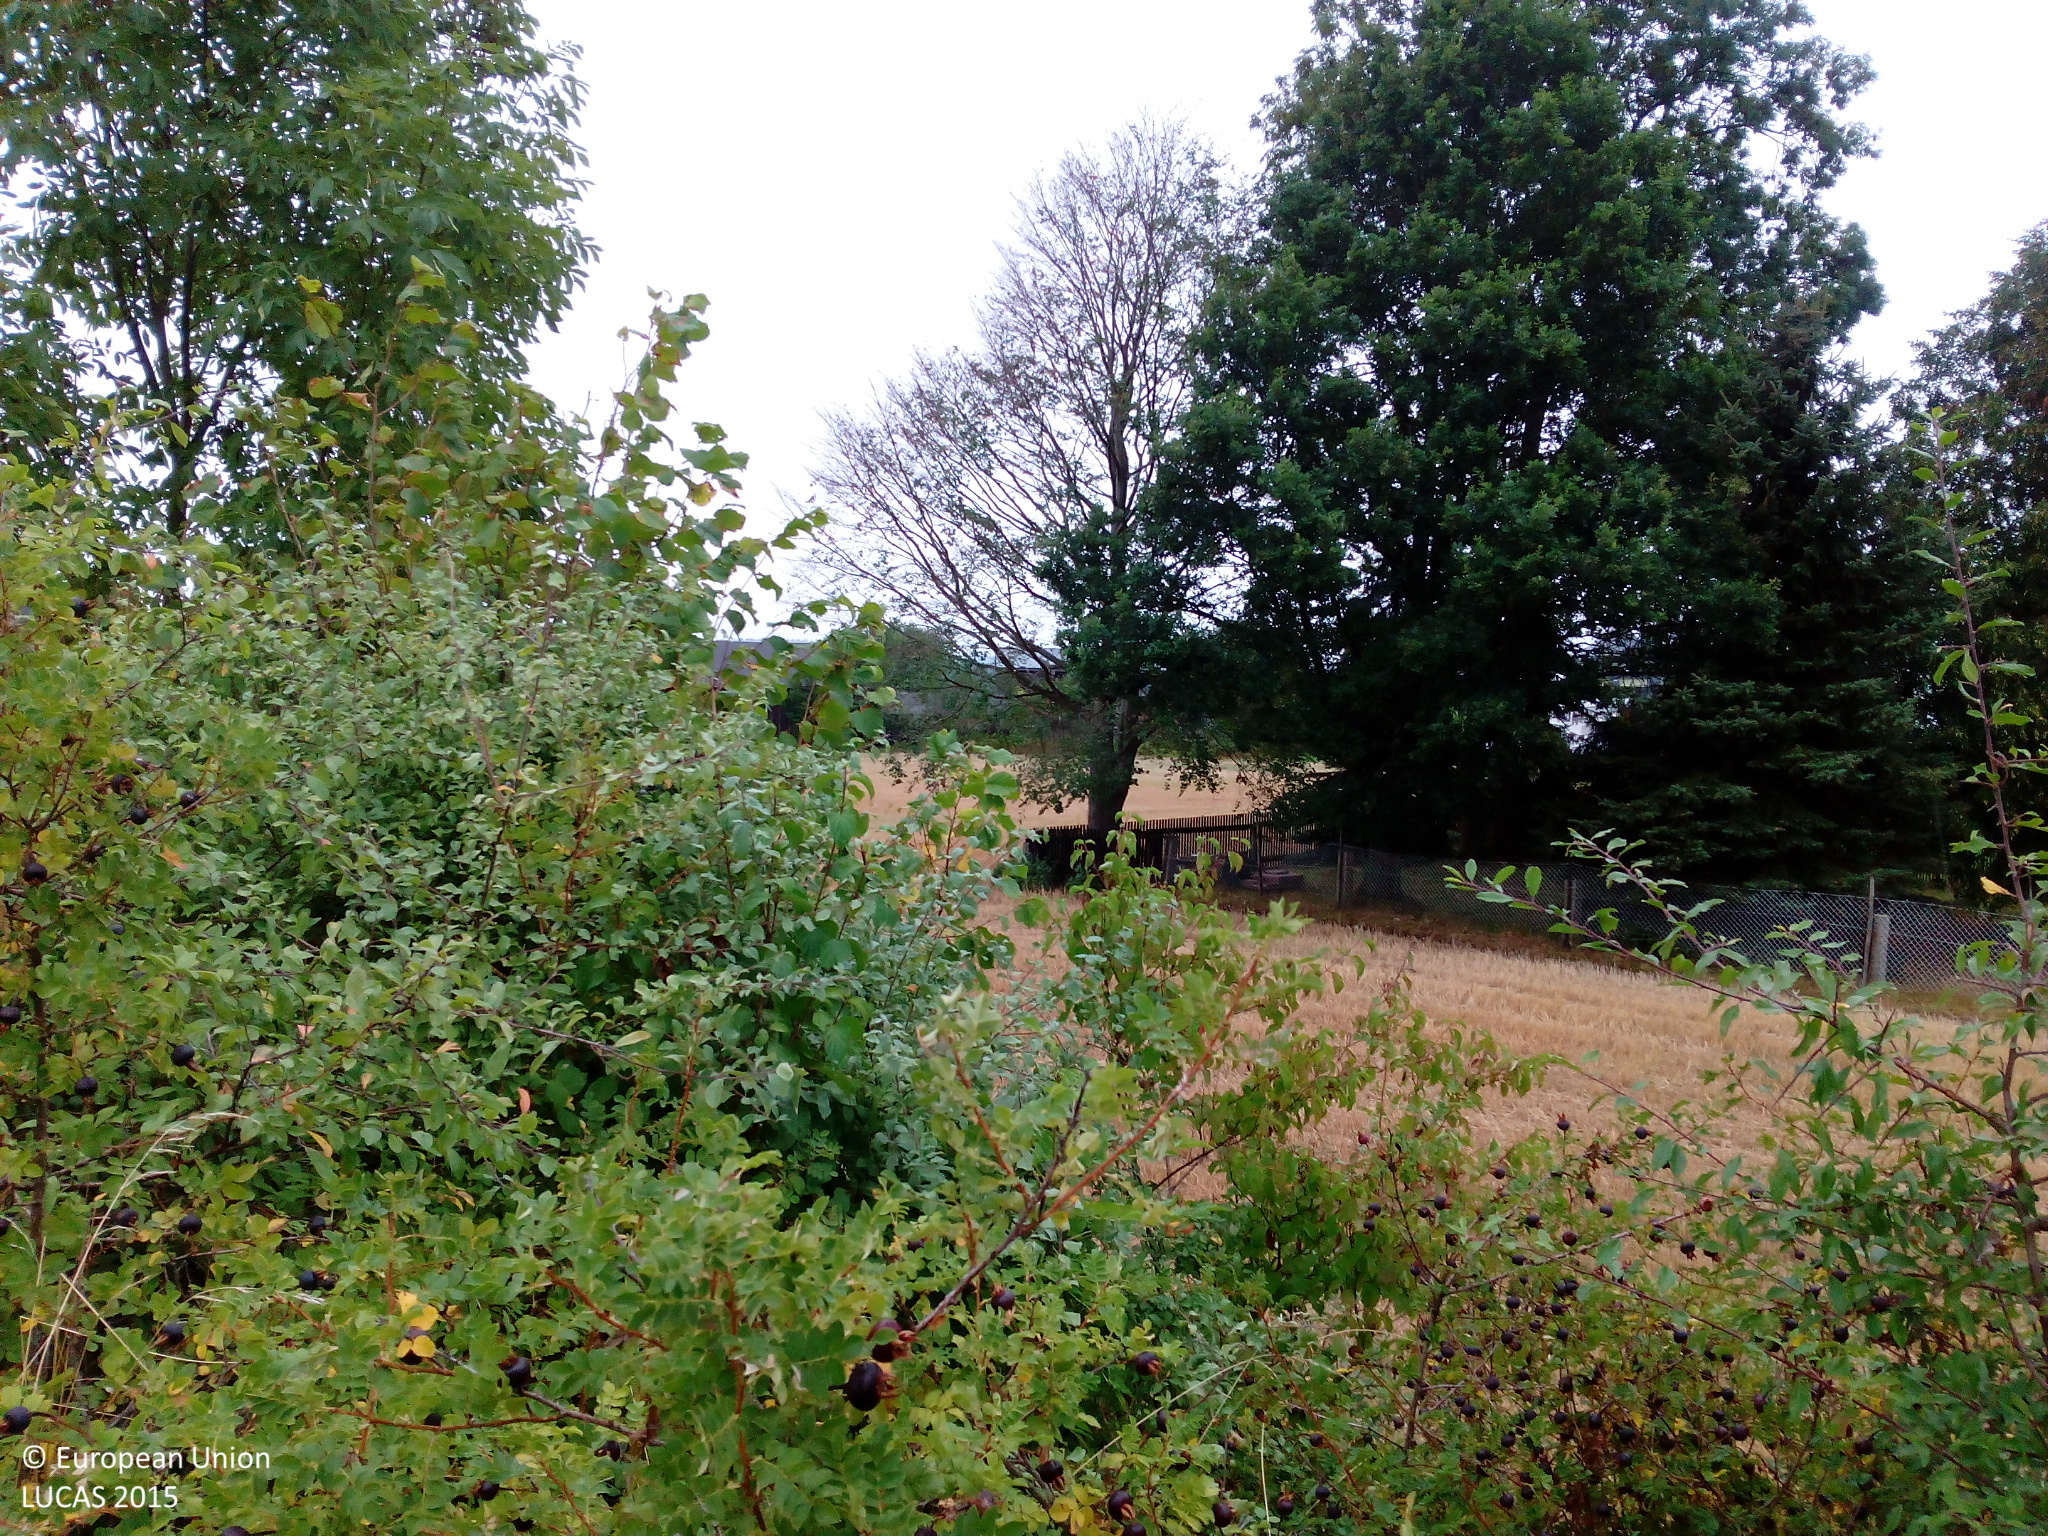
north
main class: Shrubland
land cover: Shrubland with sparse tree cover
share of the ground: > 75 %
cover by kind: shrubs 95 %, broadleaved forest trees 5 %
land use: Road transport
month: August
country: DE
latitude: 50.0933
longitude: 12.0824
